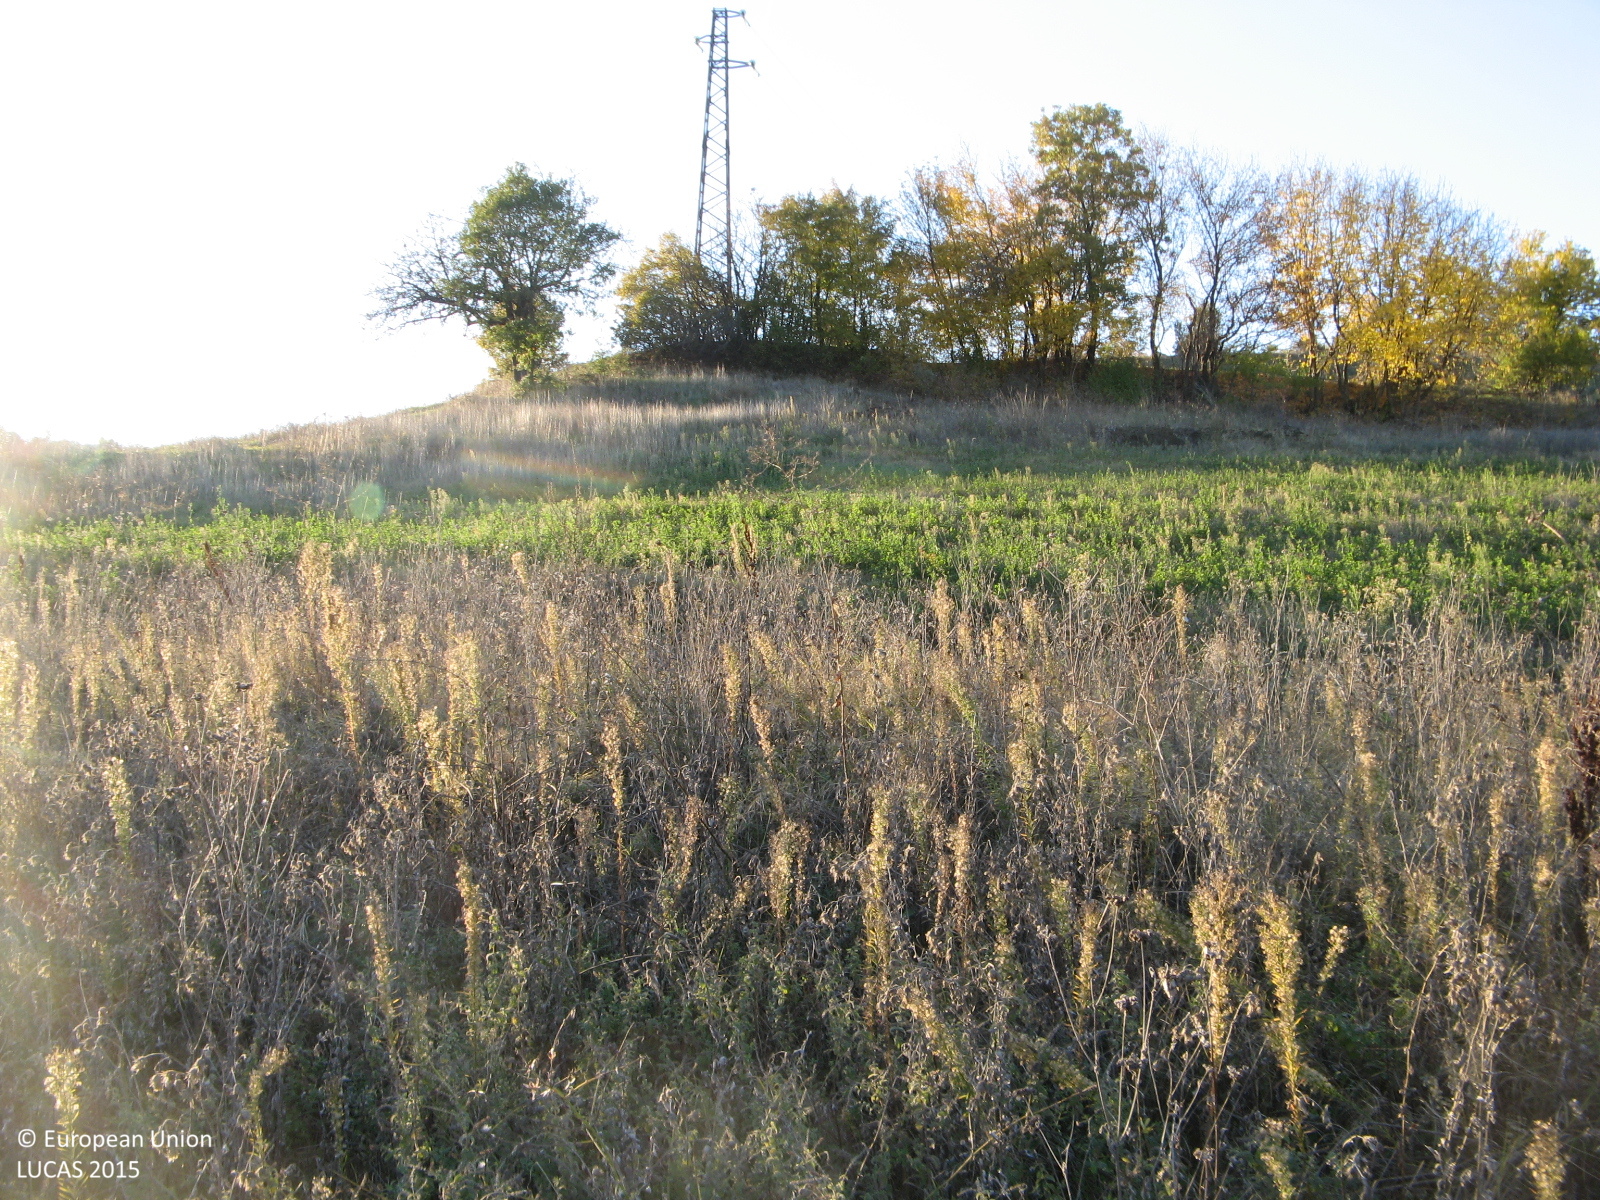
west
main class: Grassland
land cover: Spontaneously vegetated surfaces
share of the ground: > 75 %
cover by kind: herbaceous plants 100 %
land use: Fallow land
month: November
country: BG
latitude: 41.7559
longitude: 25.3195
